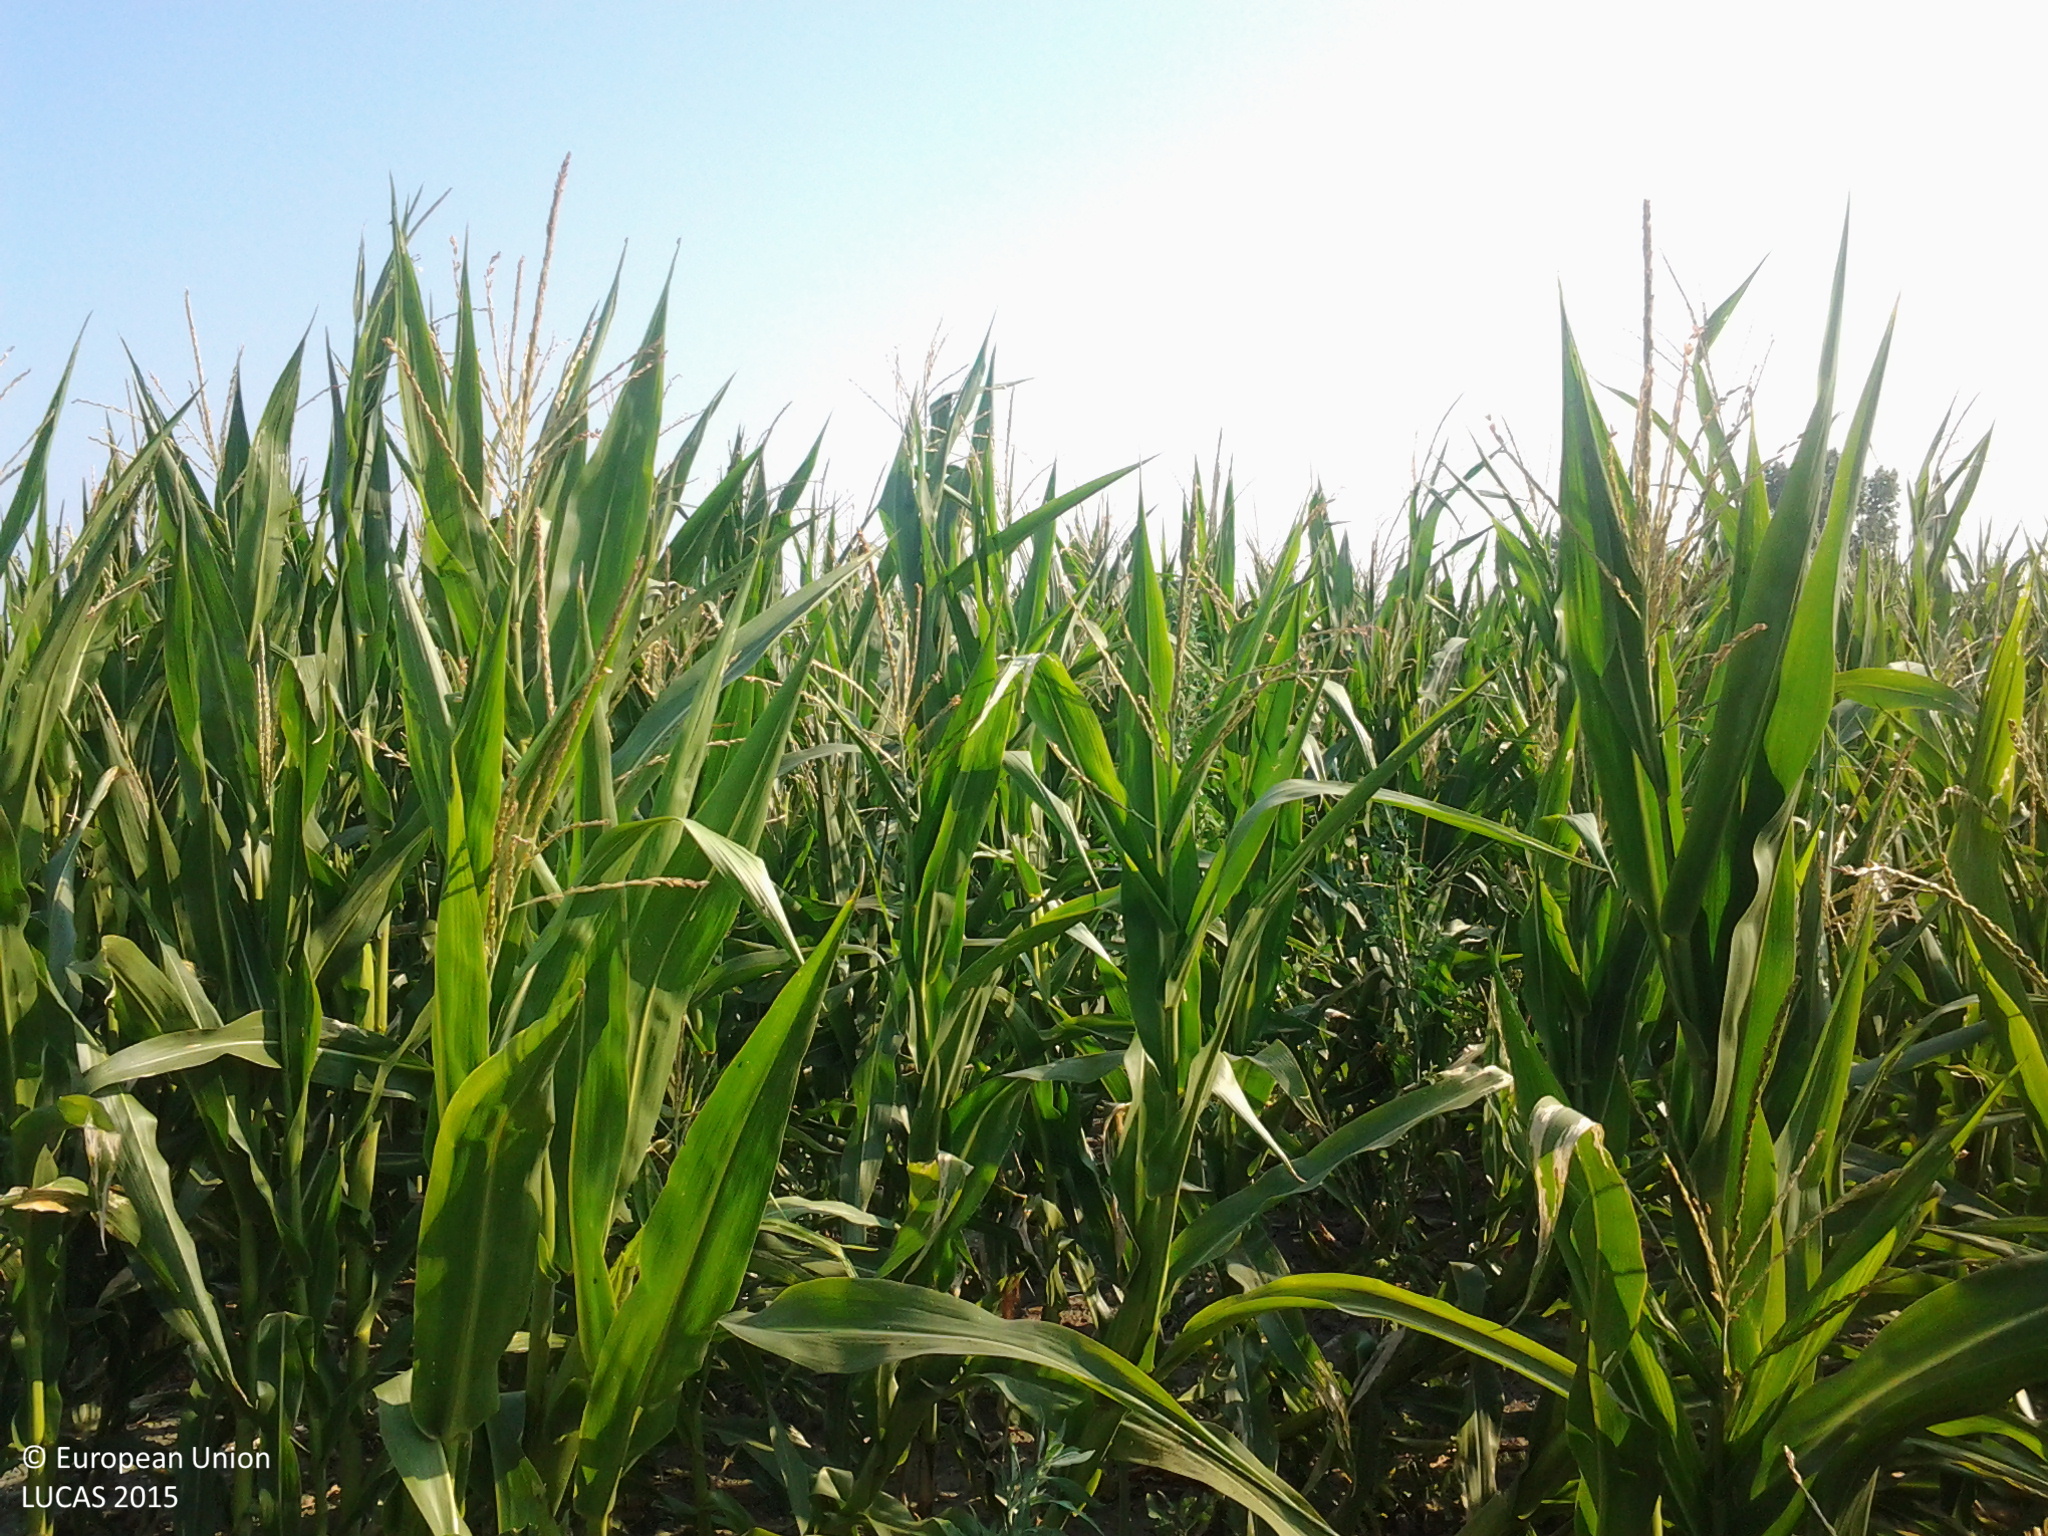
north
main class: Cropland
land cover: Maize
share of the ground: > 75 %
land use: Agriculture (excluding fallow land and kitchen gardens)
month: July
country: HU
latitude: 46.7874
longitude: 18.9877
